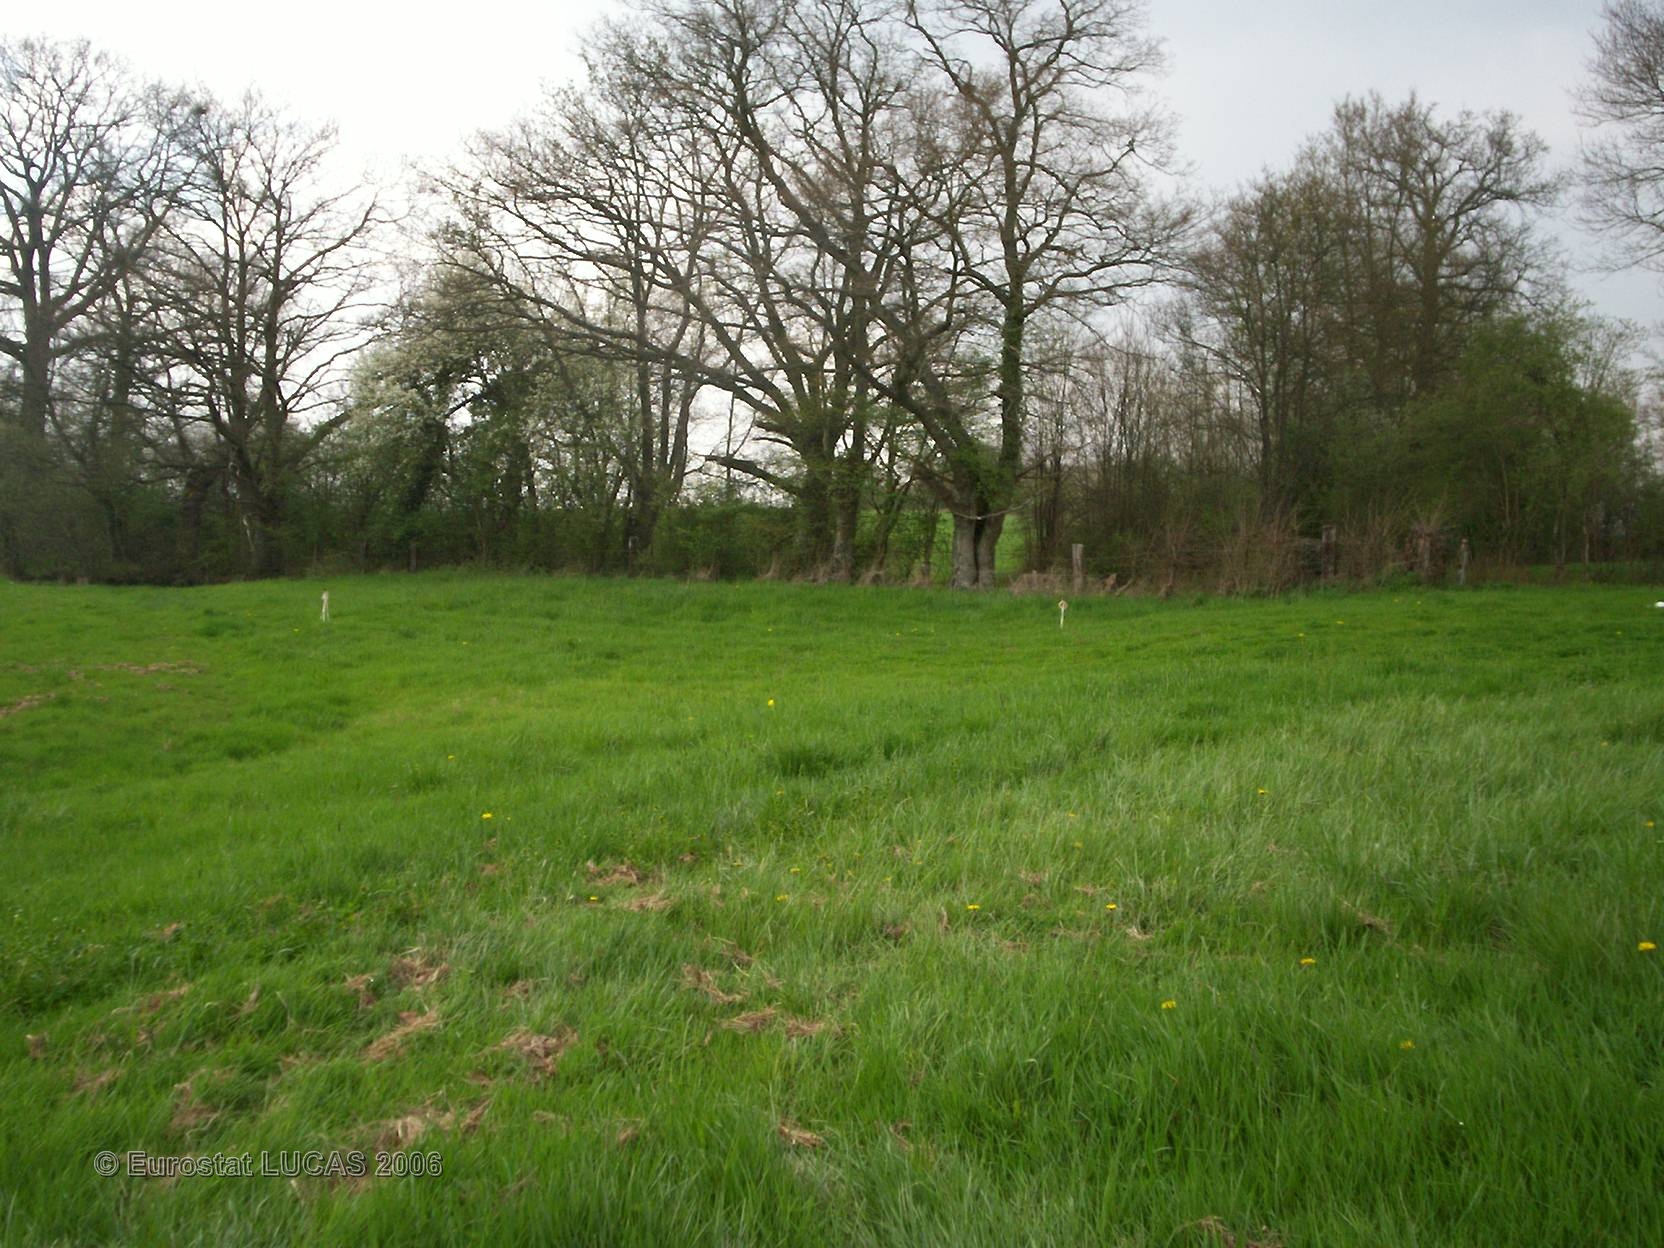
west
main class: Grassland
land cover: Grassland without tree/shrub cover
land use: Agriculture (excluding fallow land and kitchen gardens)
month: April
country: FR
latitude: 48.7055
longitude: 0.1467
